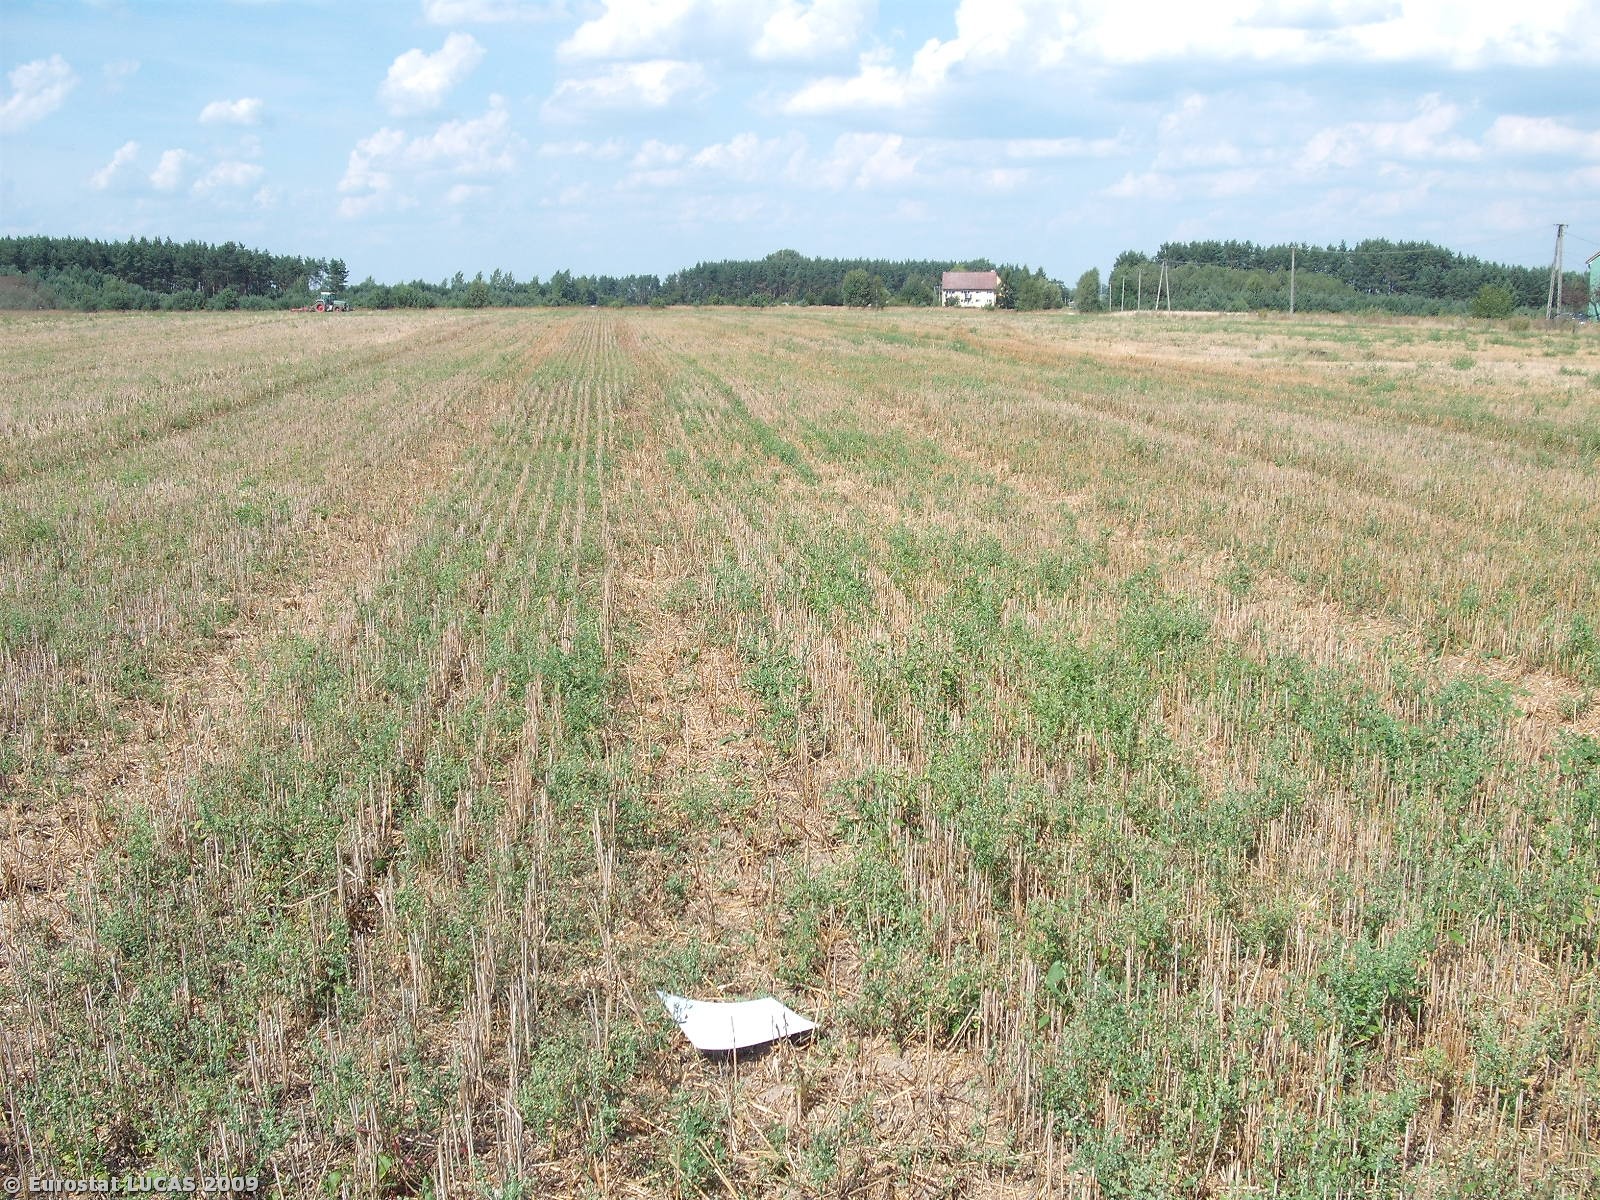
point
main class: Cropland
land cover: Triticale
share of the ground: < 10 %
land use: Agriculture (excluding fallow land and kitchen gardens)
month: August
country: PL
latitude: 50.5681
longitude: 20.7000
